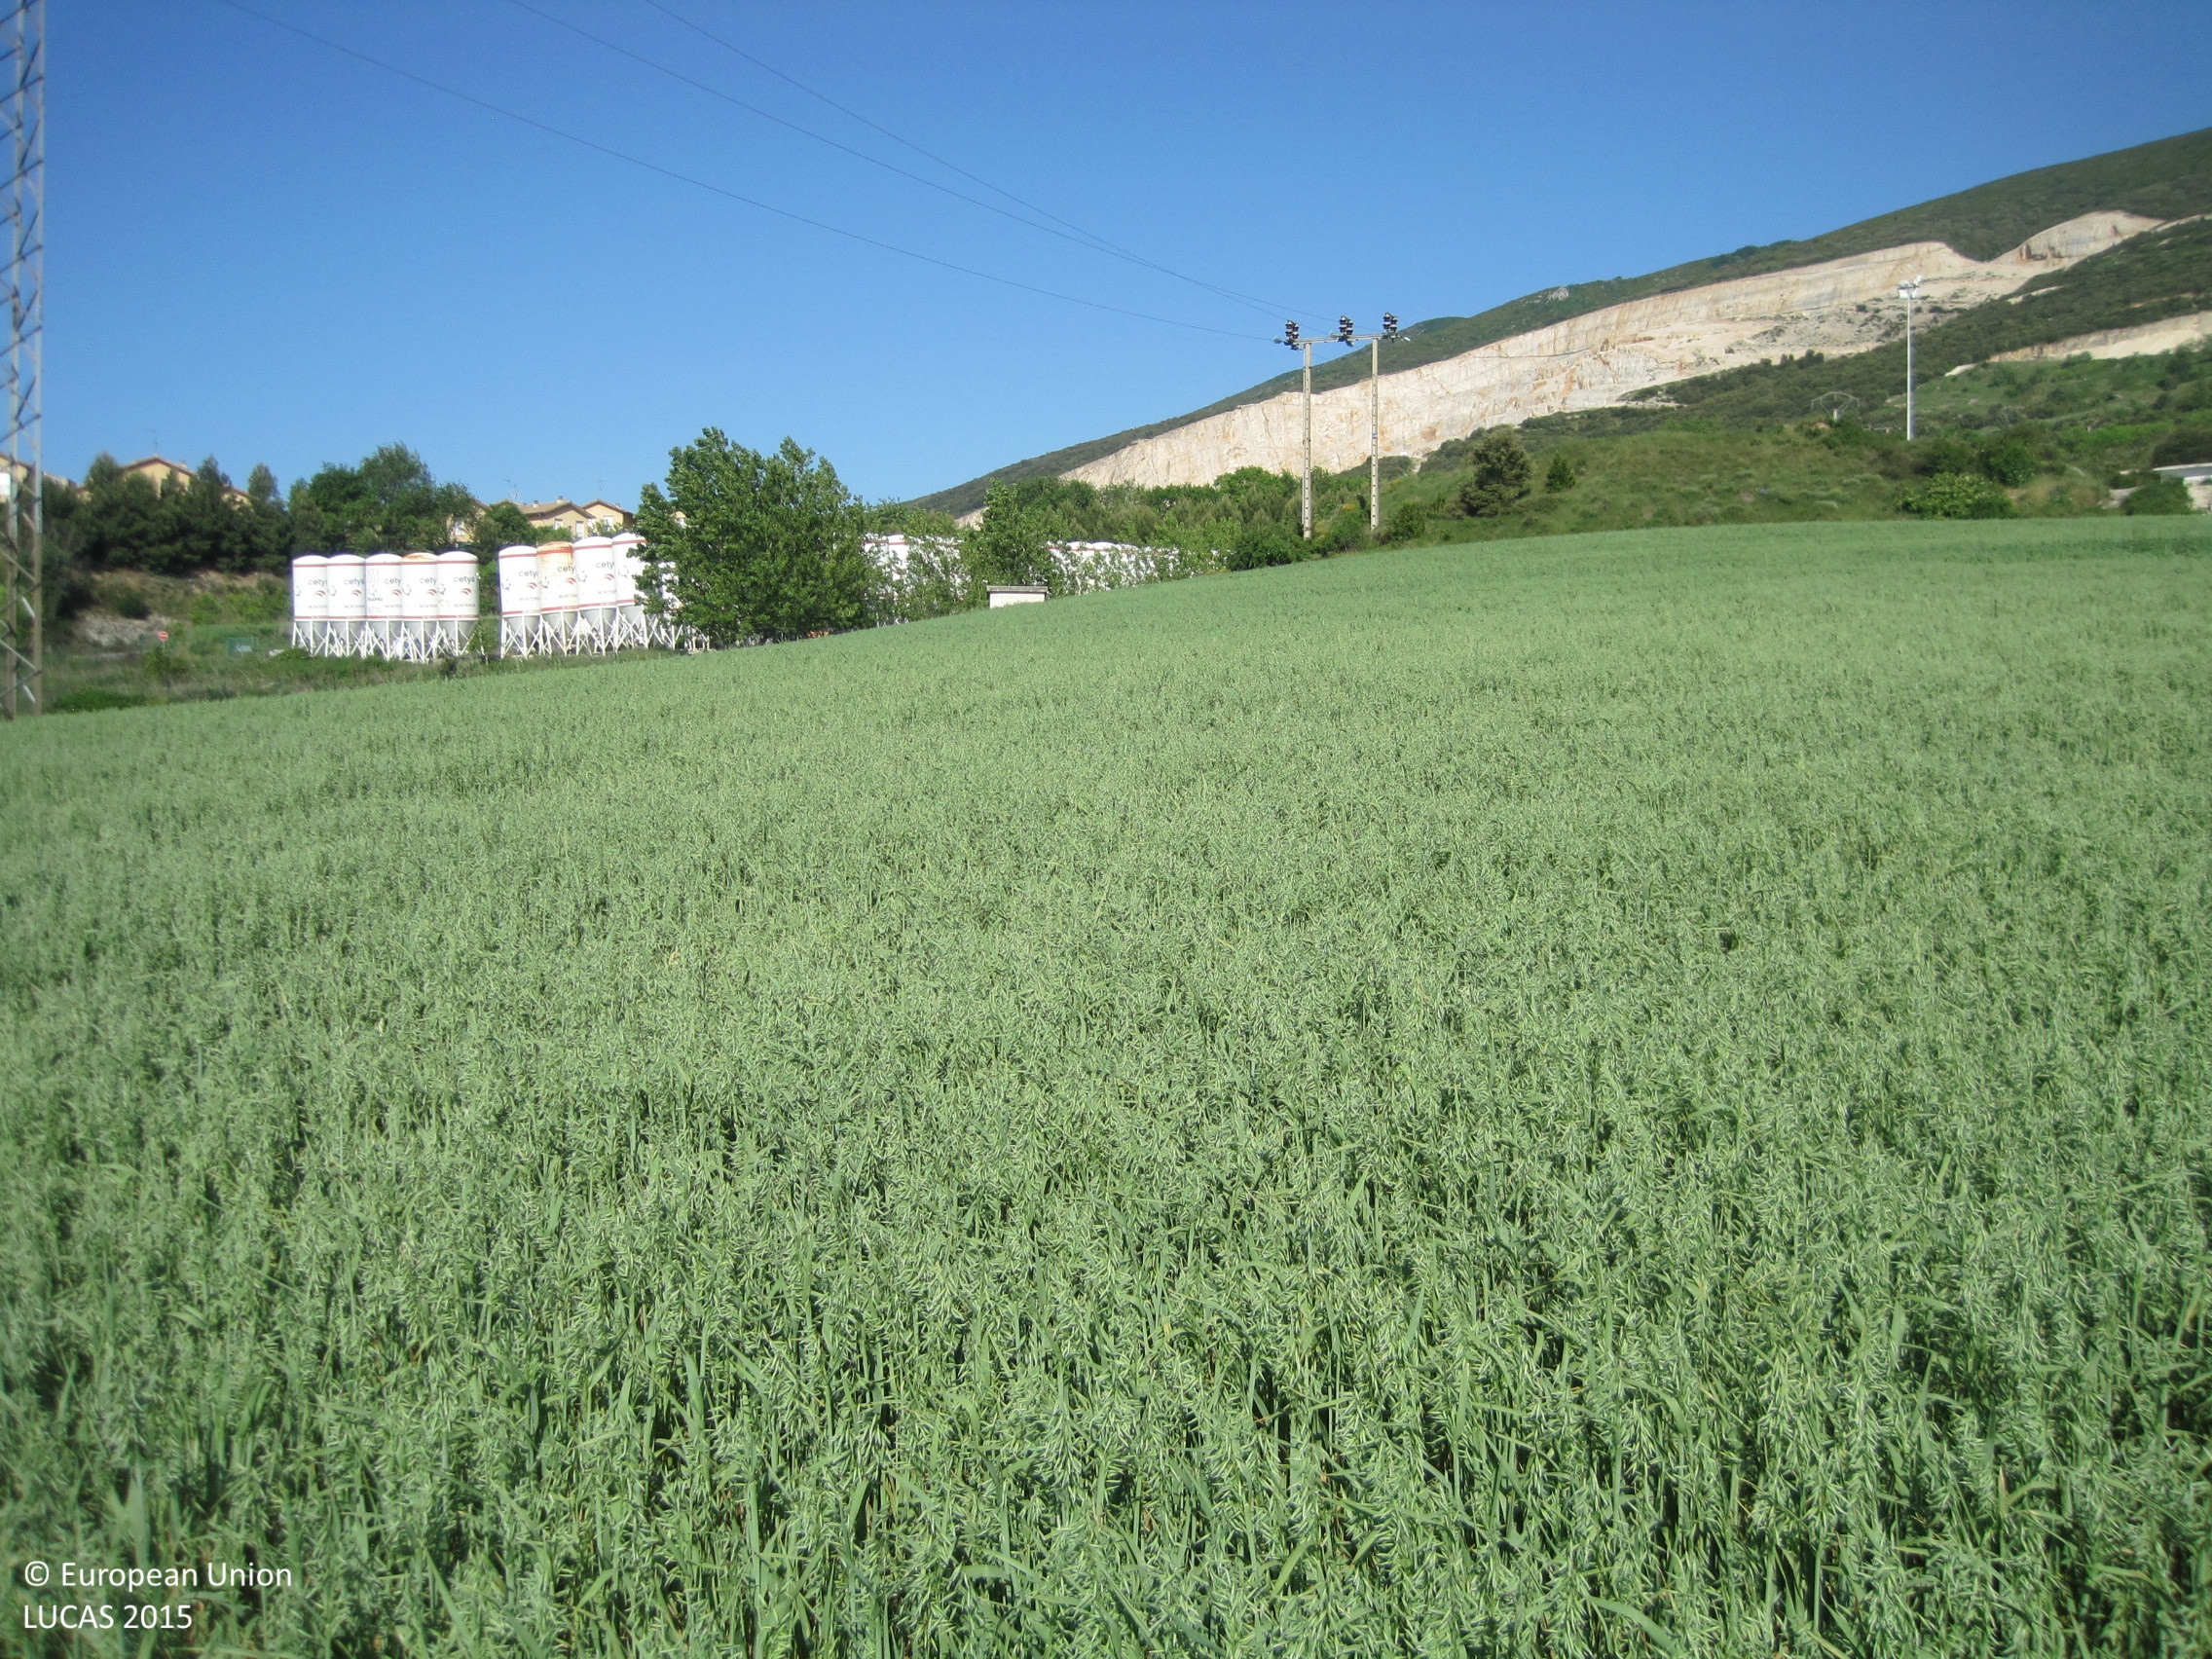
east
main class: Cropland
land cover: Oats
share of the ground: > 75 %
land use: Agriculture (excluding fallow land and kitchen gardens)
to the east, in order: Oats; Electric lines; Oats; Grassland without tree/shrub cover; Electric lines; Grassland without tree/shrub cover; Pine dominated coniferous woodland; Grass margins; Paved roads, cycling and walking lanes
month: May
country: ES
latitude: 42.6906
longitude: -1.6456
